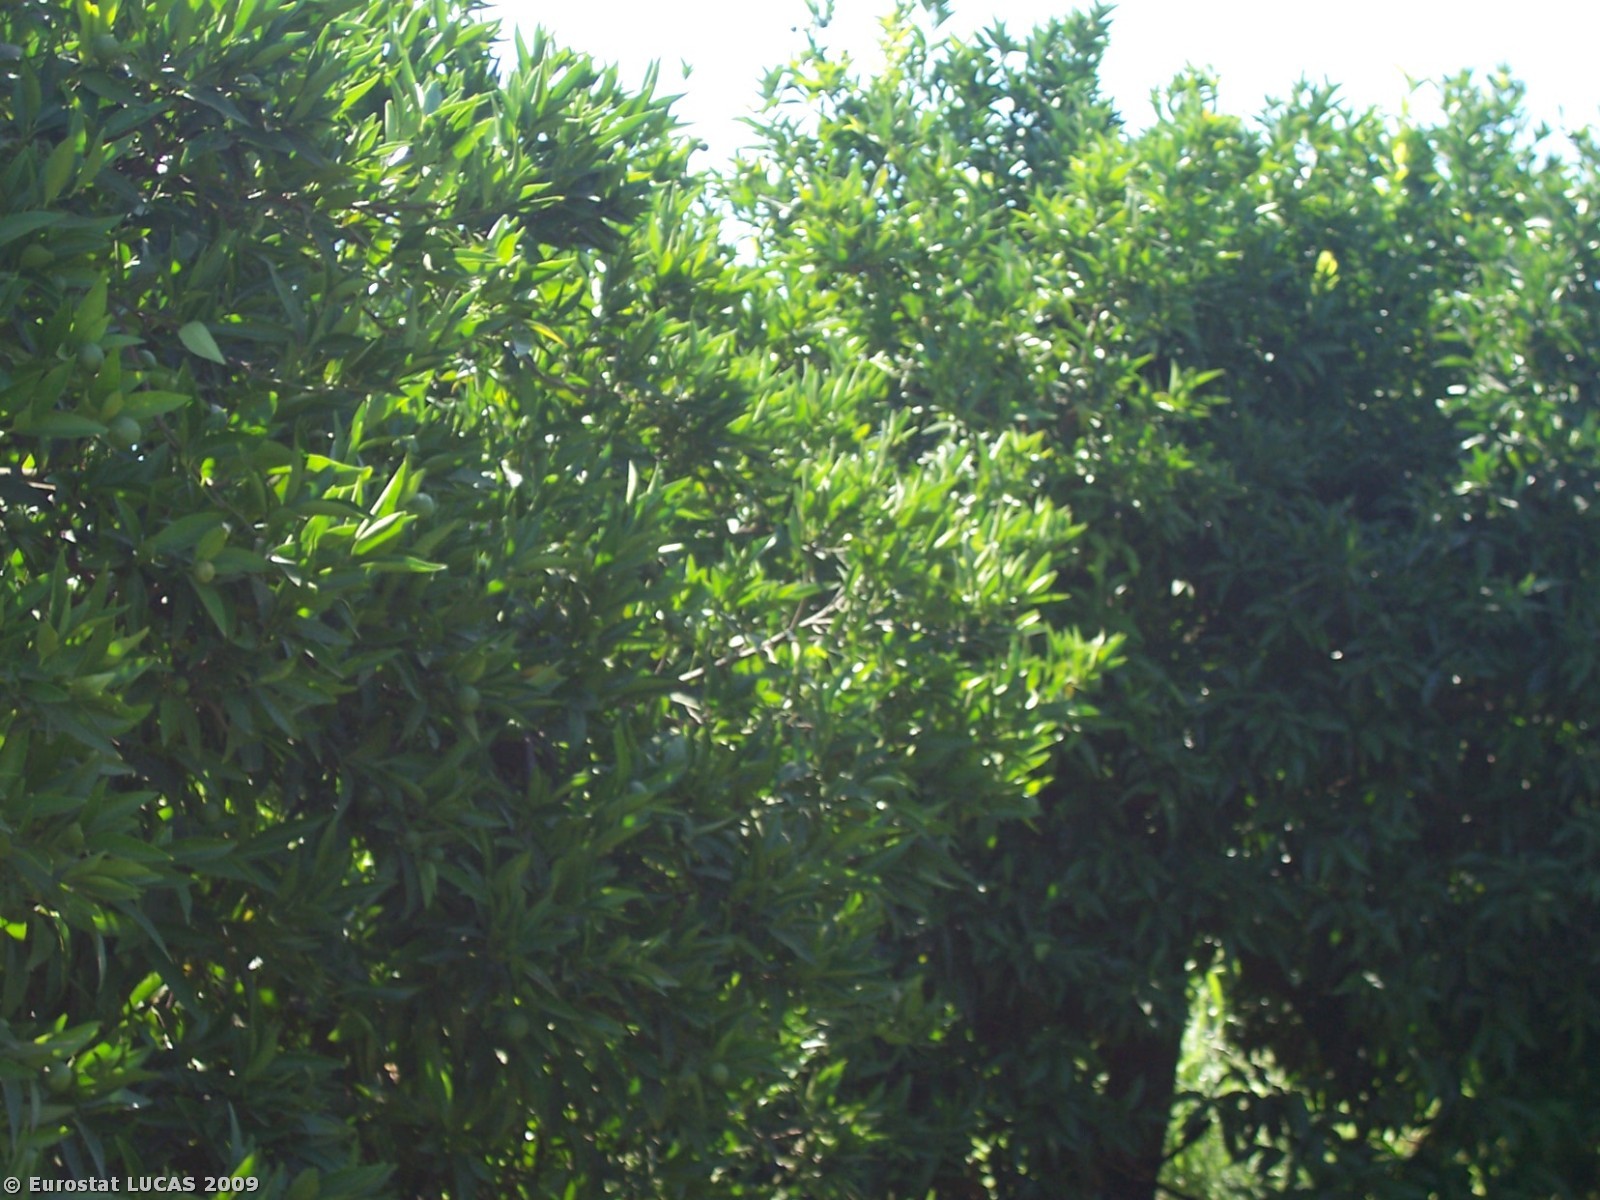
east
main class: Cropland
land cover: Other citrus fruit
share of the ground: 50 - 75 %
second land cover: Spontaneously vegetated surfaces
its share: > 75 %
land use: Agriculture (excluding fallow land and kitchen gardens)
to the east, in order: Other citrus fruit; Spontaneously vegetated surfaces; Olive groves; Spontaneously vegetated surfaces; Artificial constructions; Oranges; Spontaneously vegetated surfaces
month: July
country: IT
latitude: 40.5795
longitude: 17.0054
